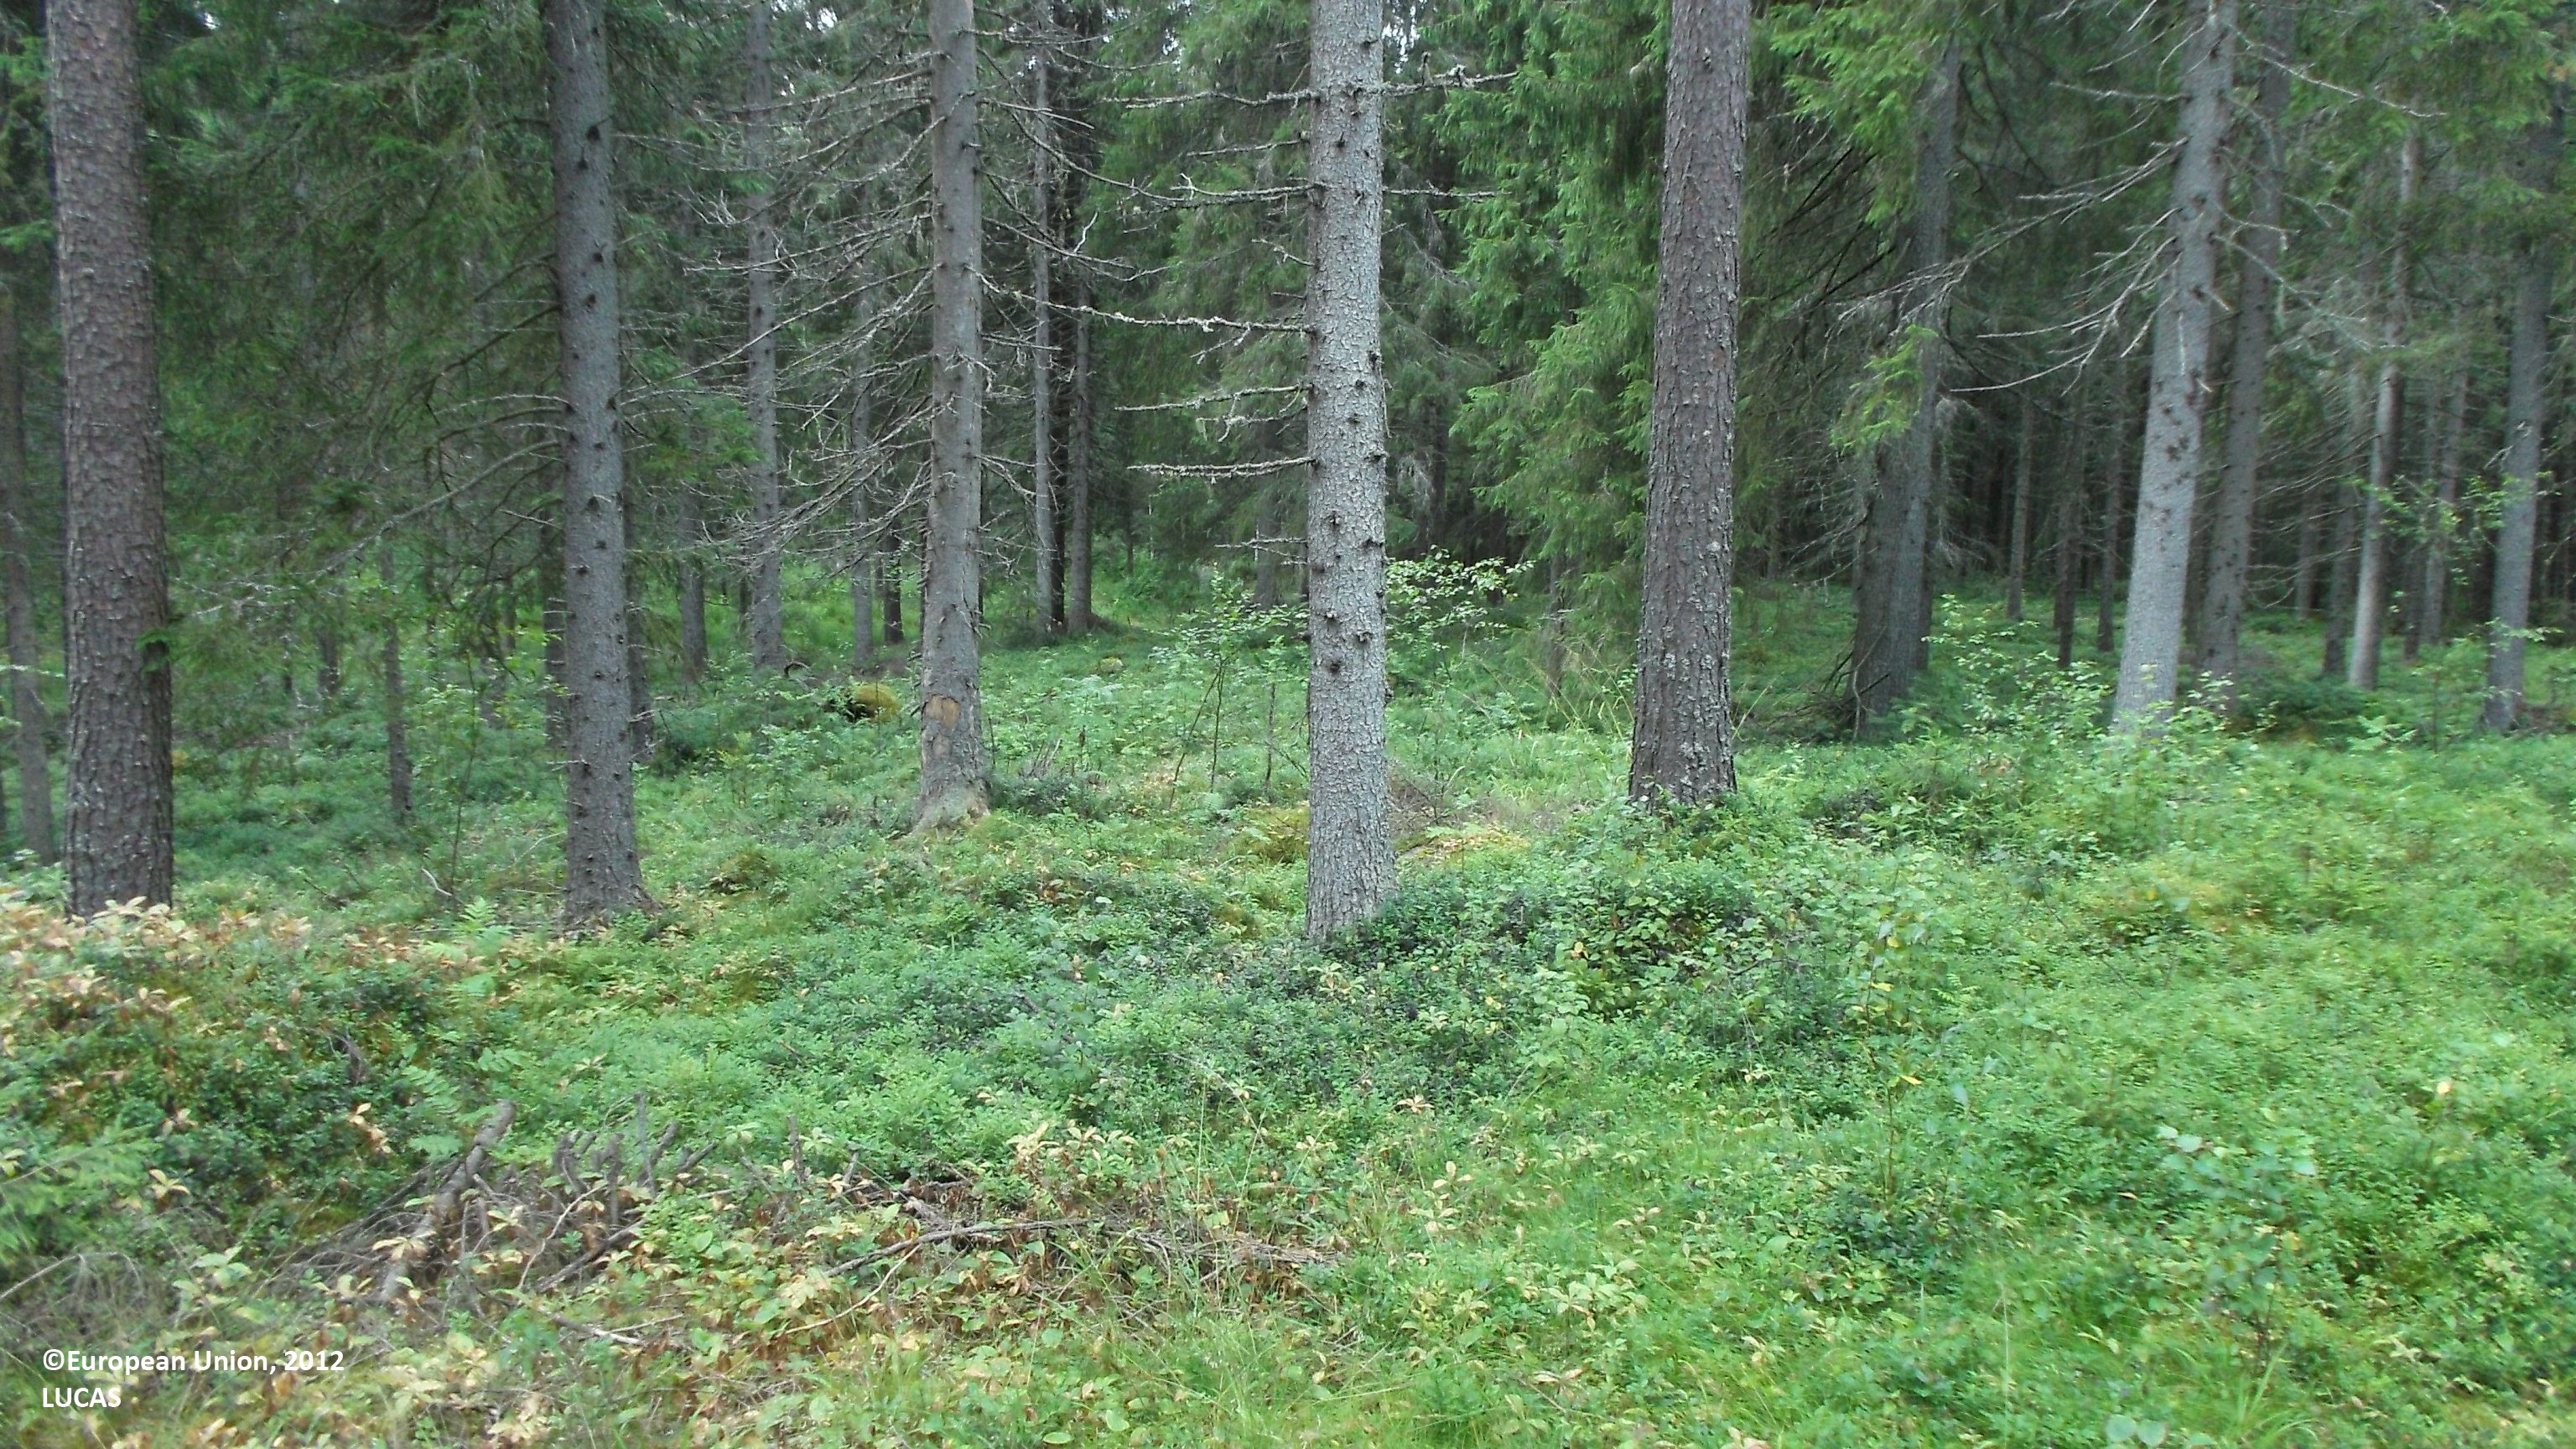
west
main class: Woodland
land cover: Other mixed woodland
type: boreal forest
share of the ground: 25 - 50 %
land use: Forestry
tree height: > 5 m
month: August
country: FI
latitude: 63.9285
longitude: 23.4972
